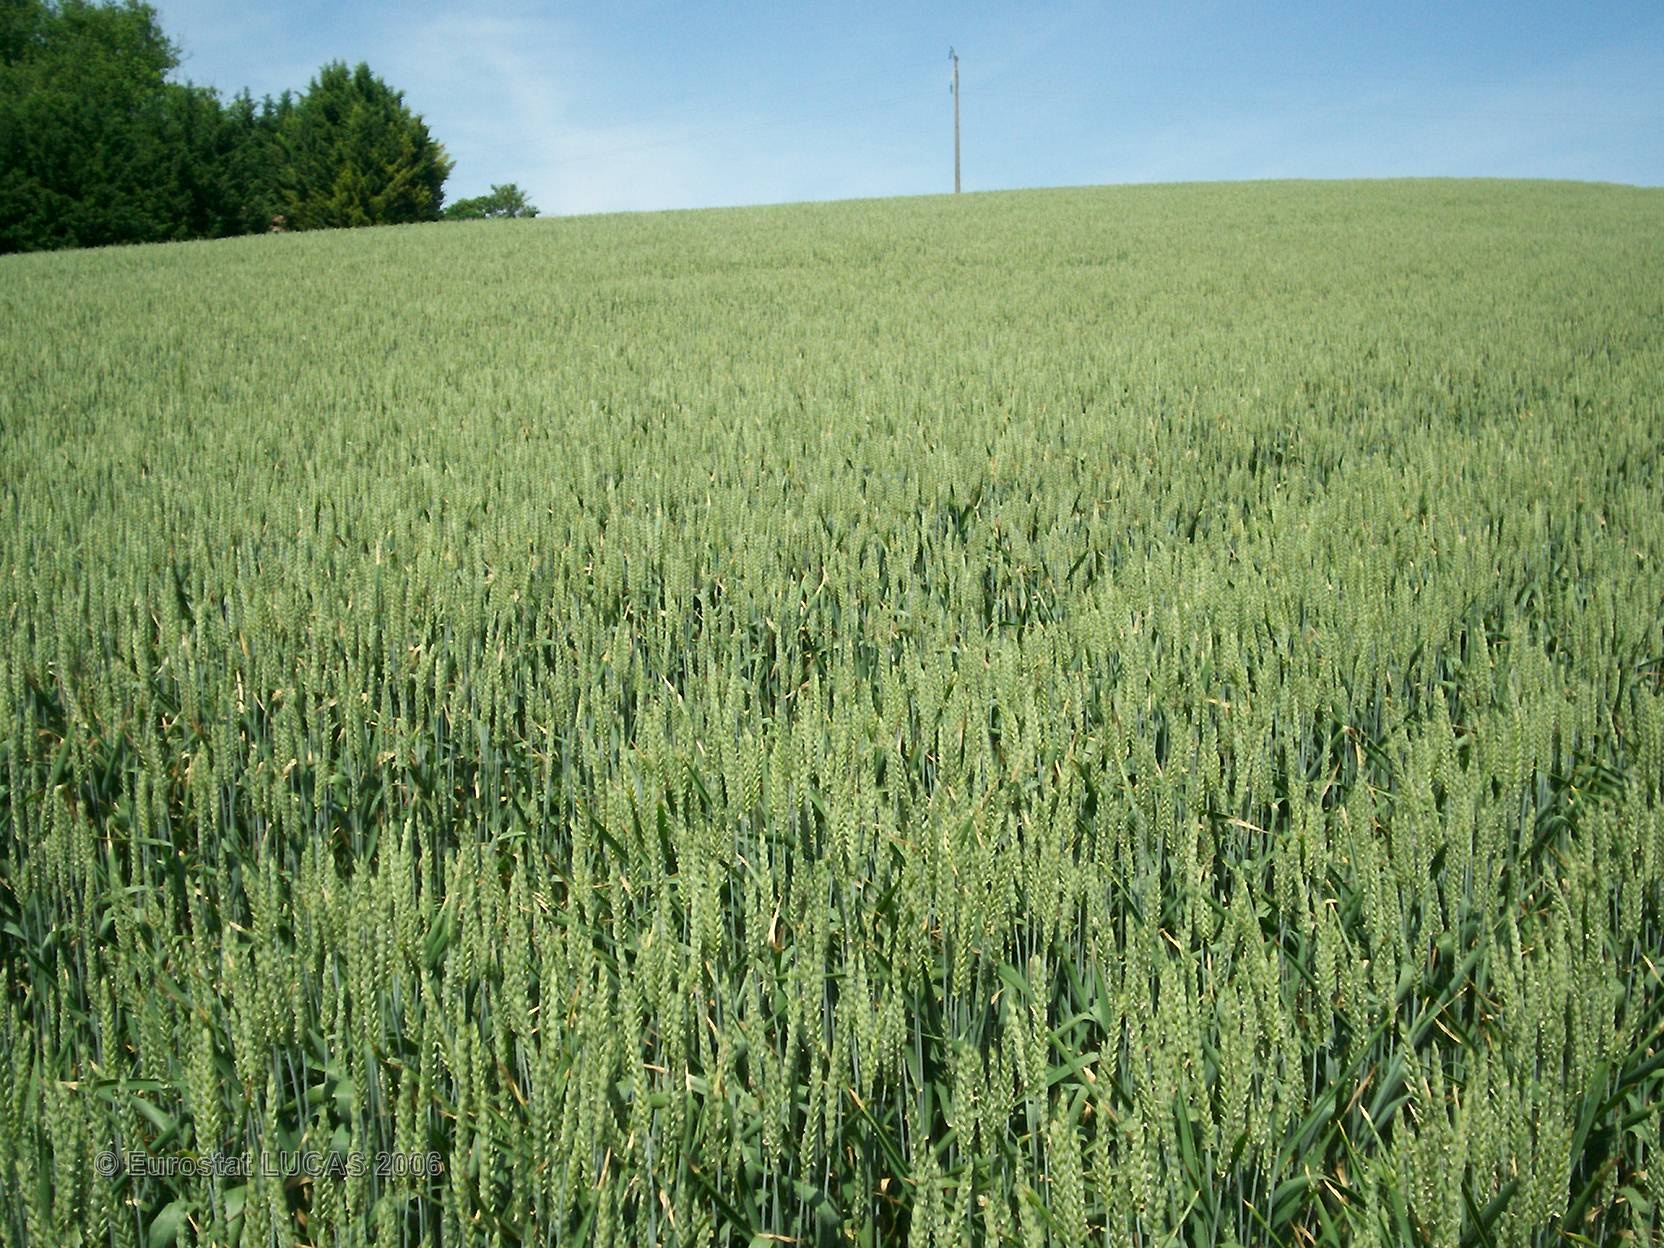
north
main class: Cropland
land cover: Common wheat
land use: Agriculture (excluding fallow land and kitchen gardens)
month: May
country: FR
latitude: 43.6178
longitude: 1.0414
